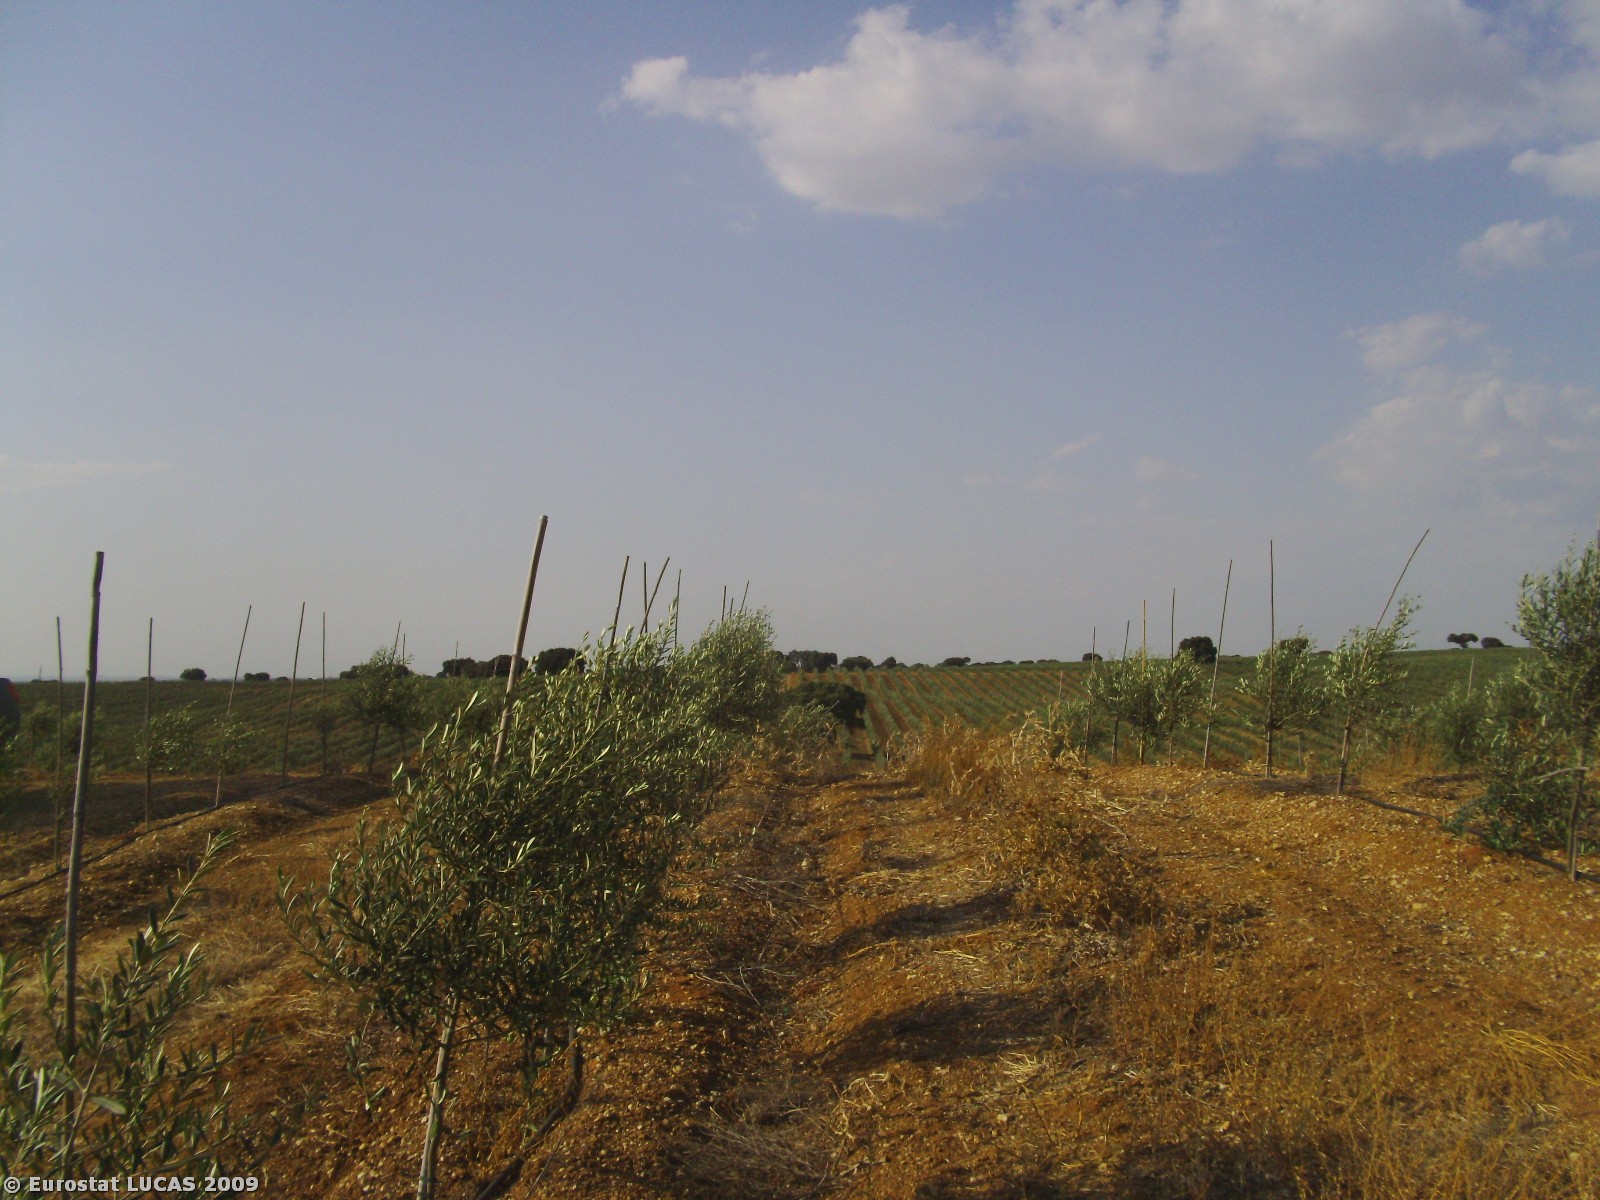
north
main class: Cropland
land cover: Olive groves
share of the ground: 50 - 75 %
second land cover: Spontaneously vegetated surfaces
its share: > 75 %
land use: Agriculture (excluding fallow land and kitchen gardens)
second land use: Fallow land
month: August
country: PT
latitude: 37.8762
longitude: -8.3286
